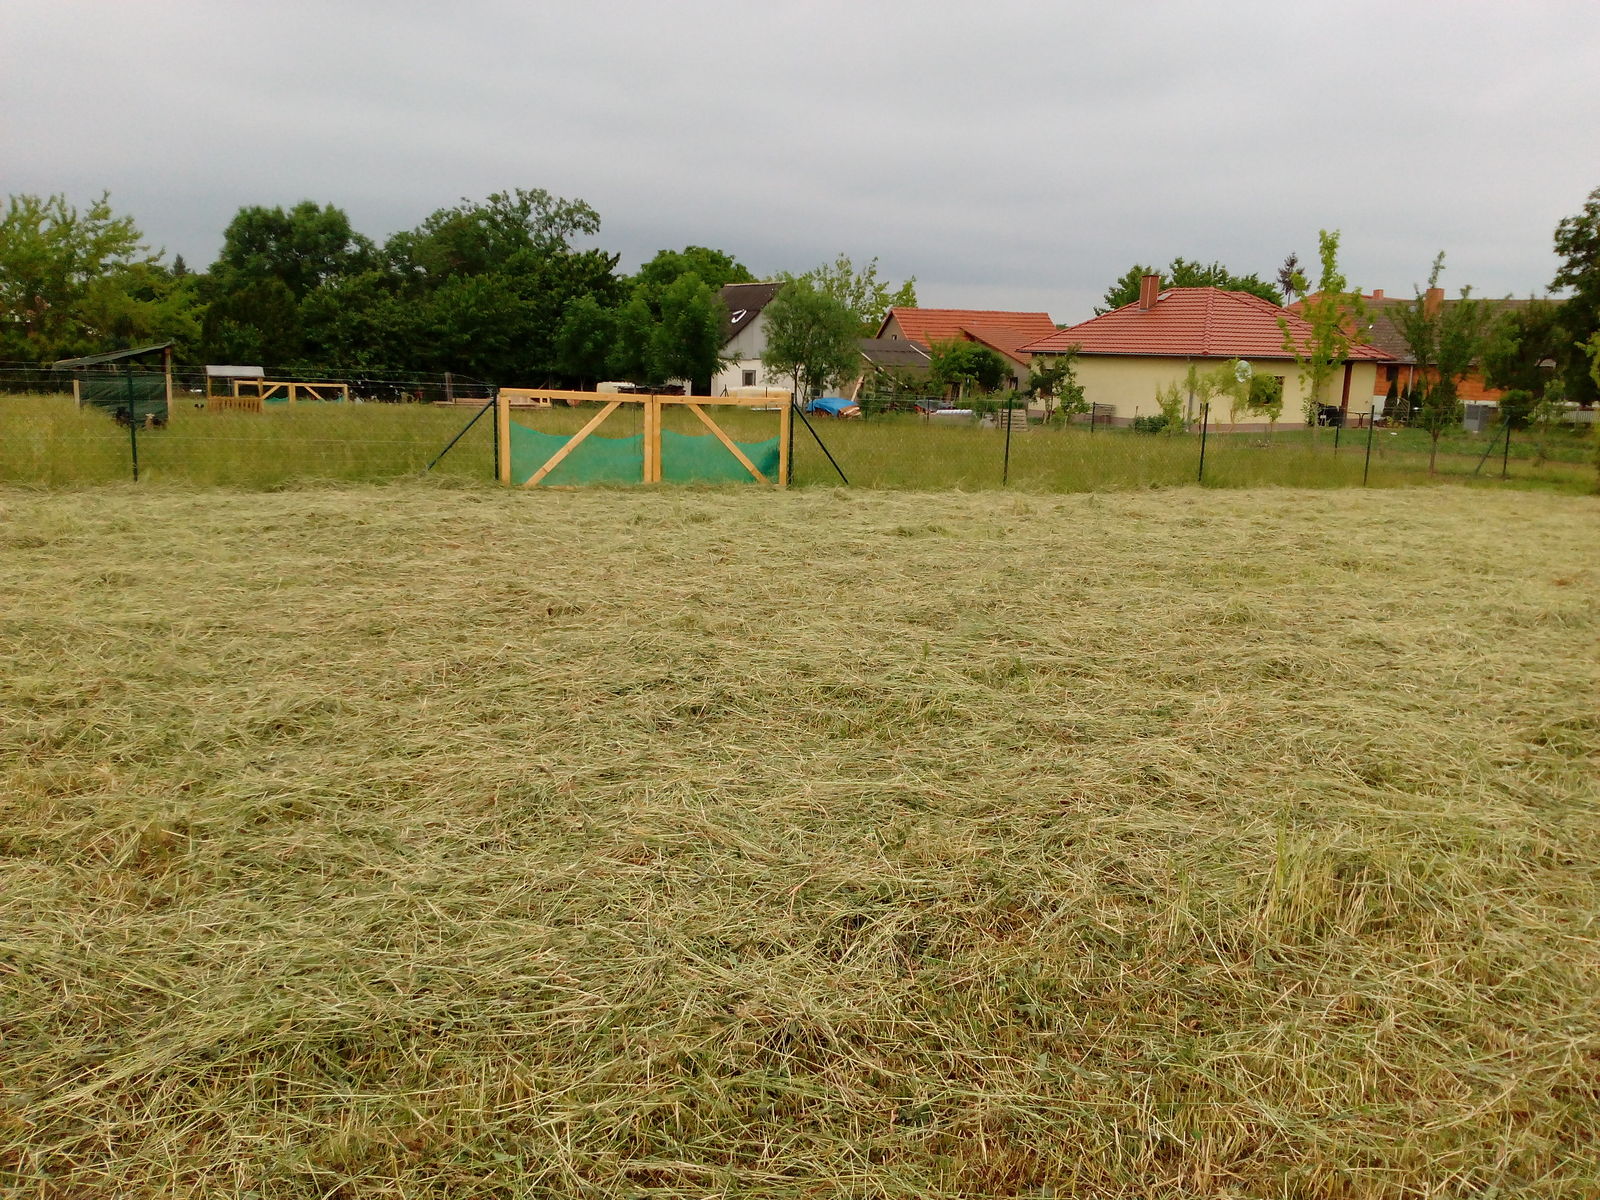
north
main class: Grassland
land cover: Grassland without tree/shrub cover
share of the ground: > 75 %
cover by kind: herbaceous plants 100 %
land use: Agriculture (excluding fallow land and kitchen gardens)
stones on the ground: < 10 %
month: June
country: DE
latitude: 51.0636
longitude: 10.6134
